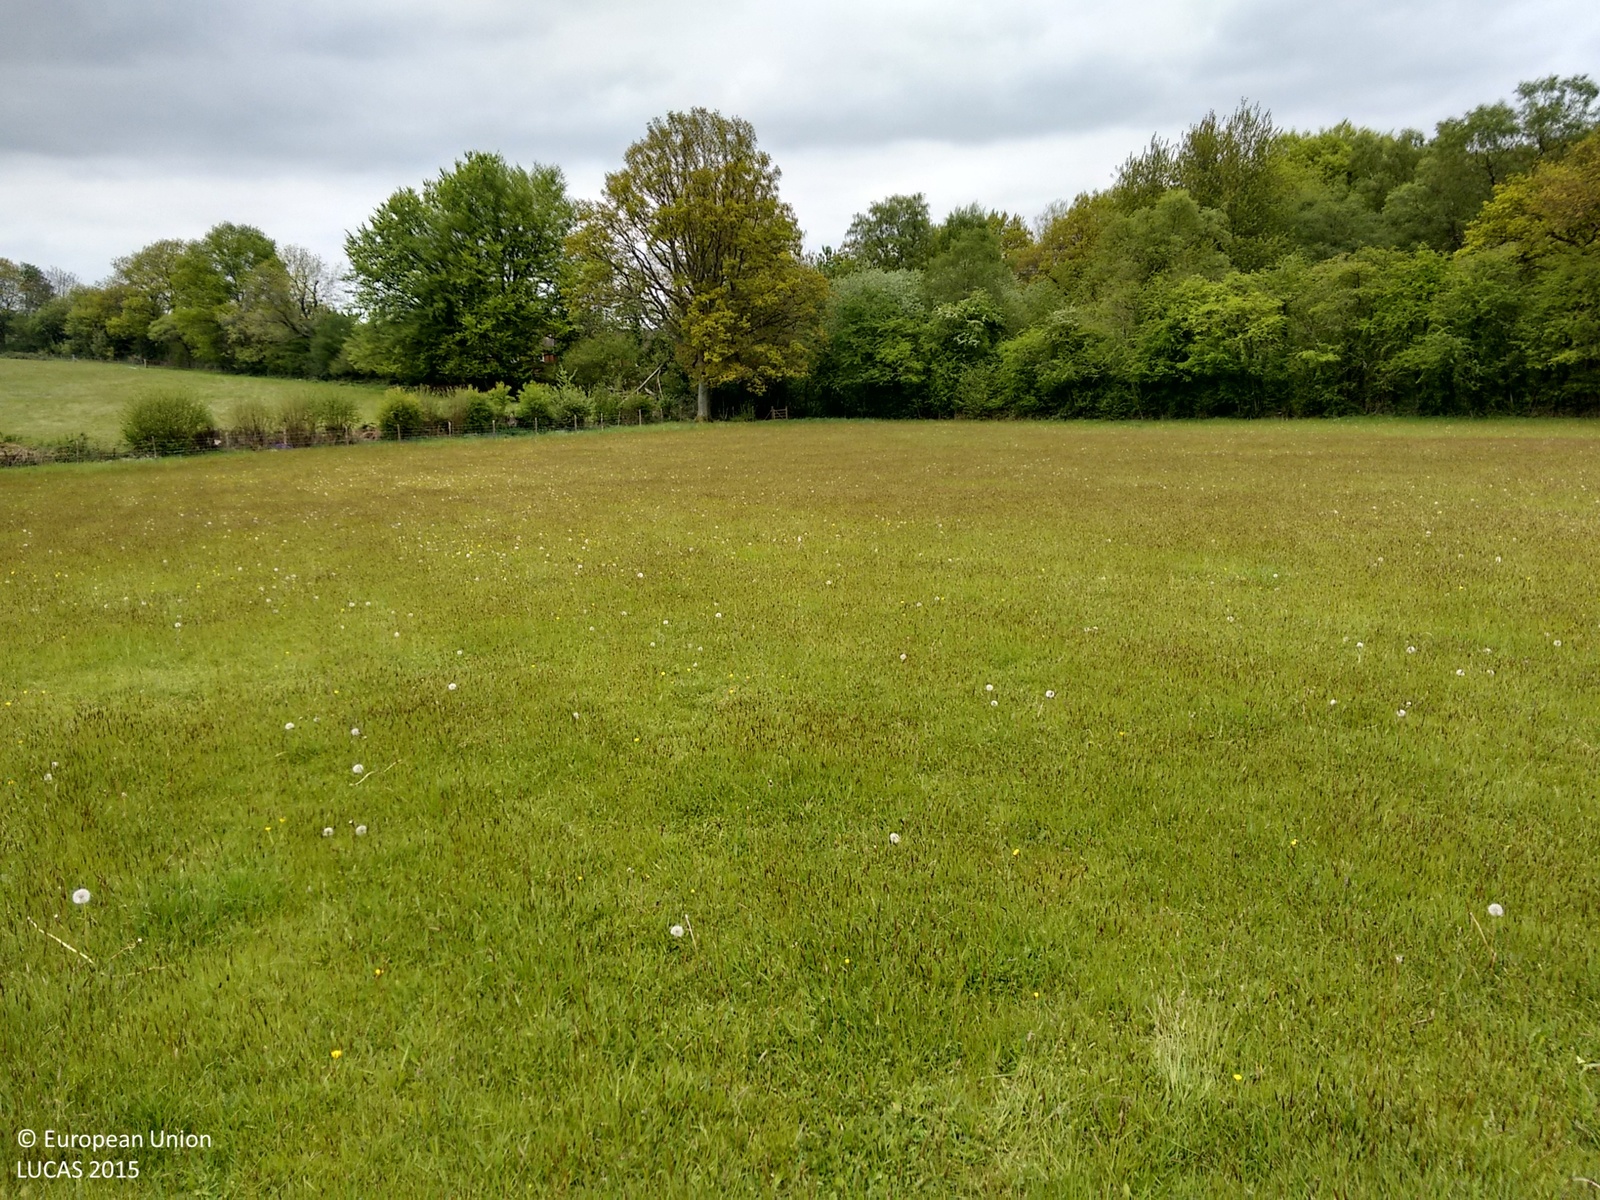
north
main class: Grassland
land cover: Grassland without tree/shrub cover
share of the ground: > 75 %
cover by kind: herbaceous plants 100 %
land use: Agriculture (excluding fallow land and kitchen gardens)
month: May
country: GB
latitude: 51.0315
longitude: -0.9811
